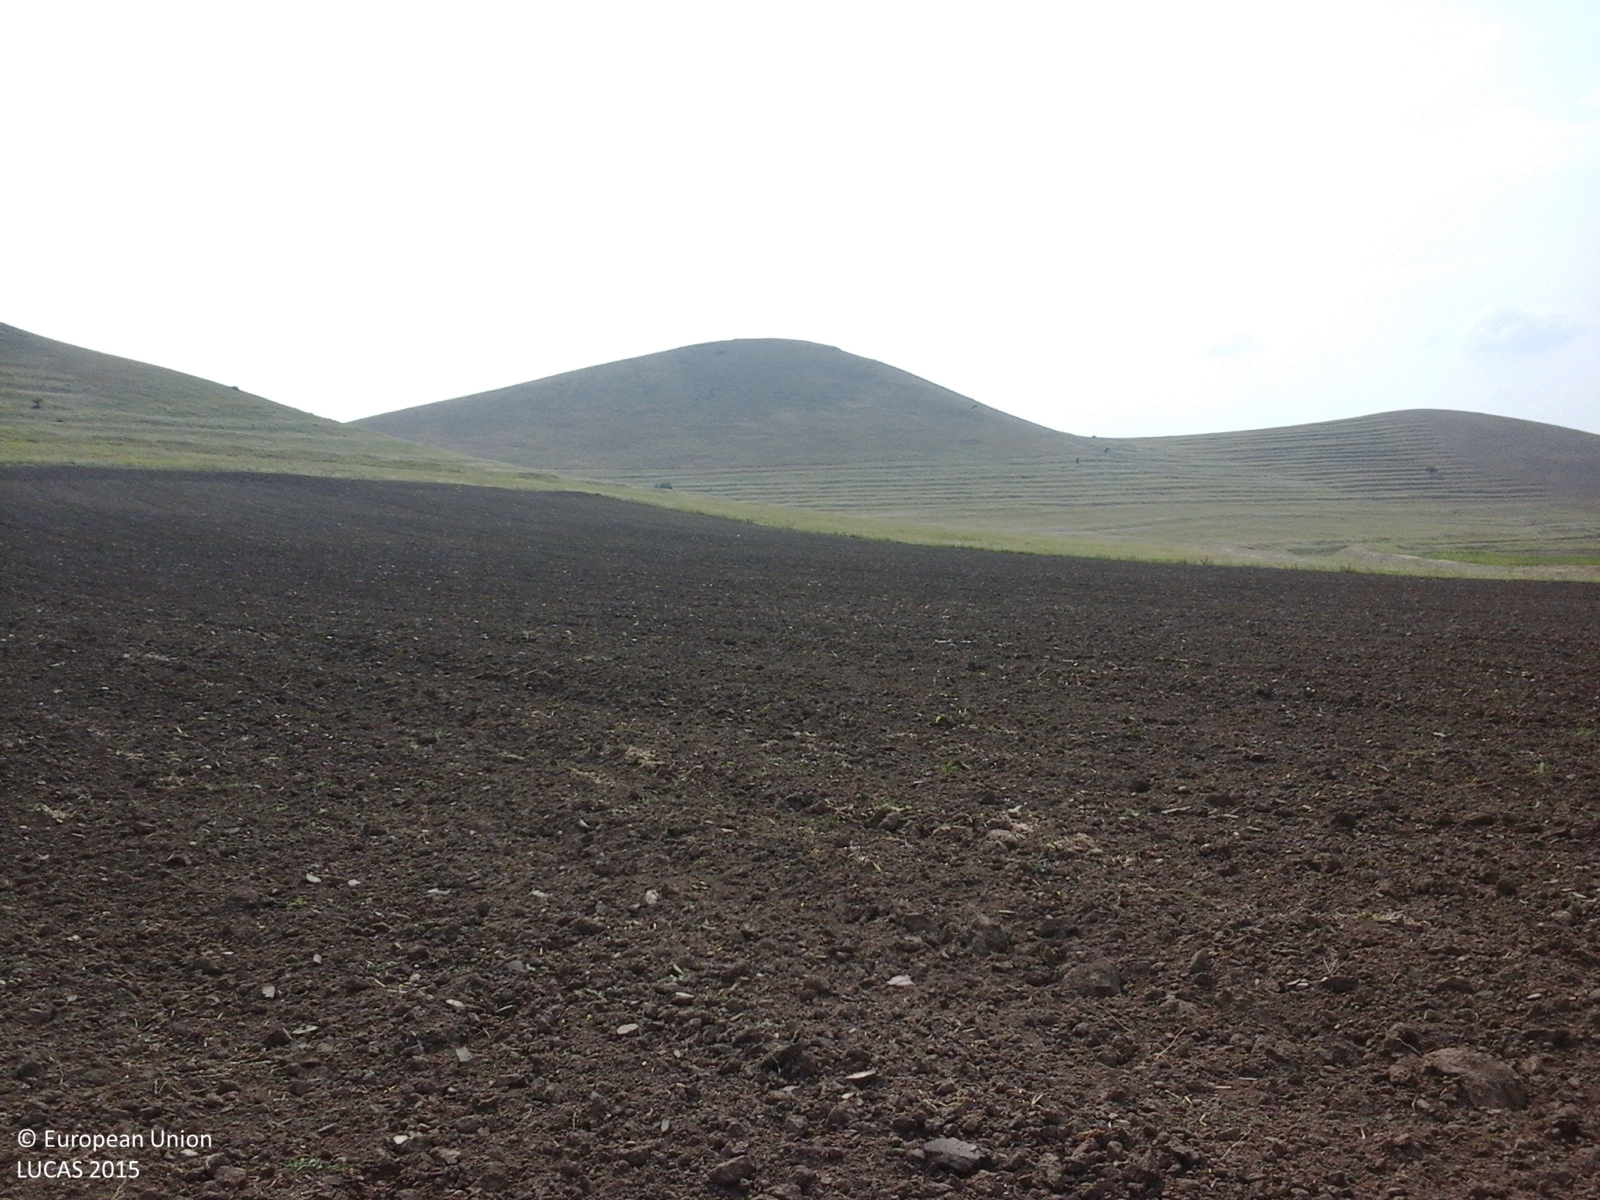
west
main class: Cropland
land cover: Rape and turnip rape
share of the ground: < 10 %
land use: Agriculture (excluding fallow land and kitchen gardens)
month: July
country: RO
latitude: 45.1168
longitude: 28.2356
